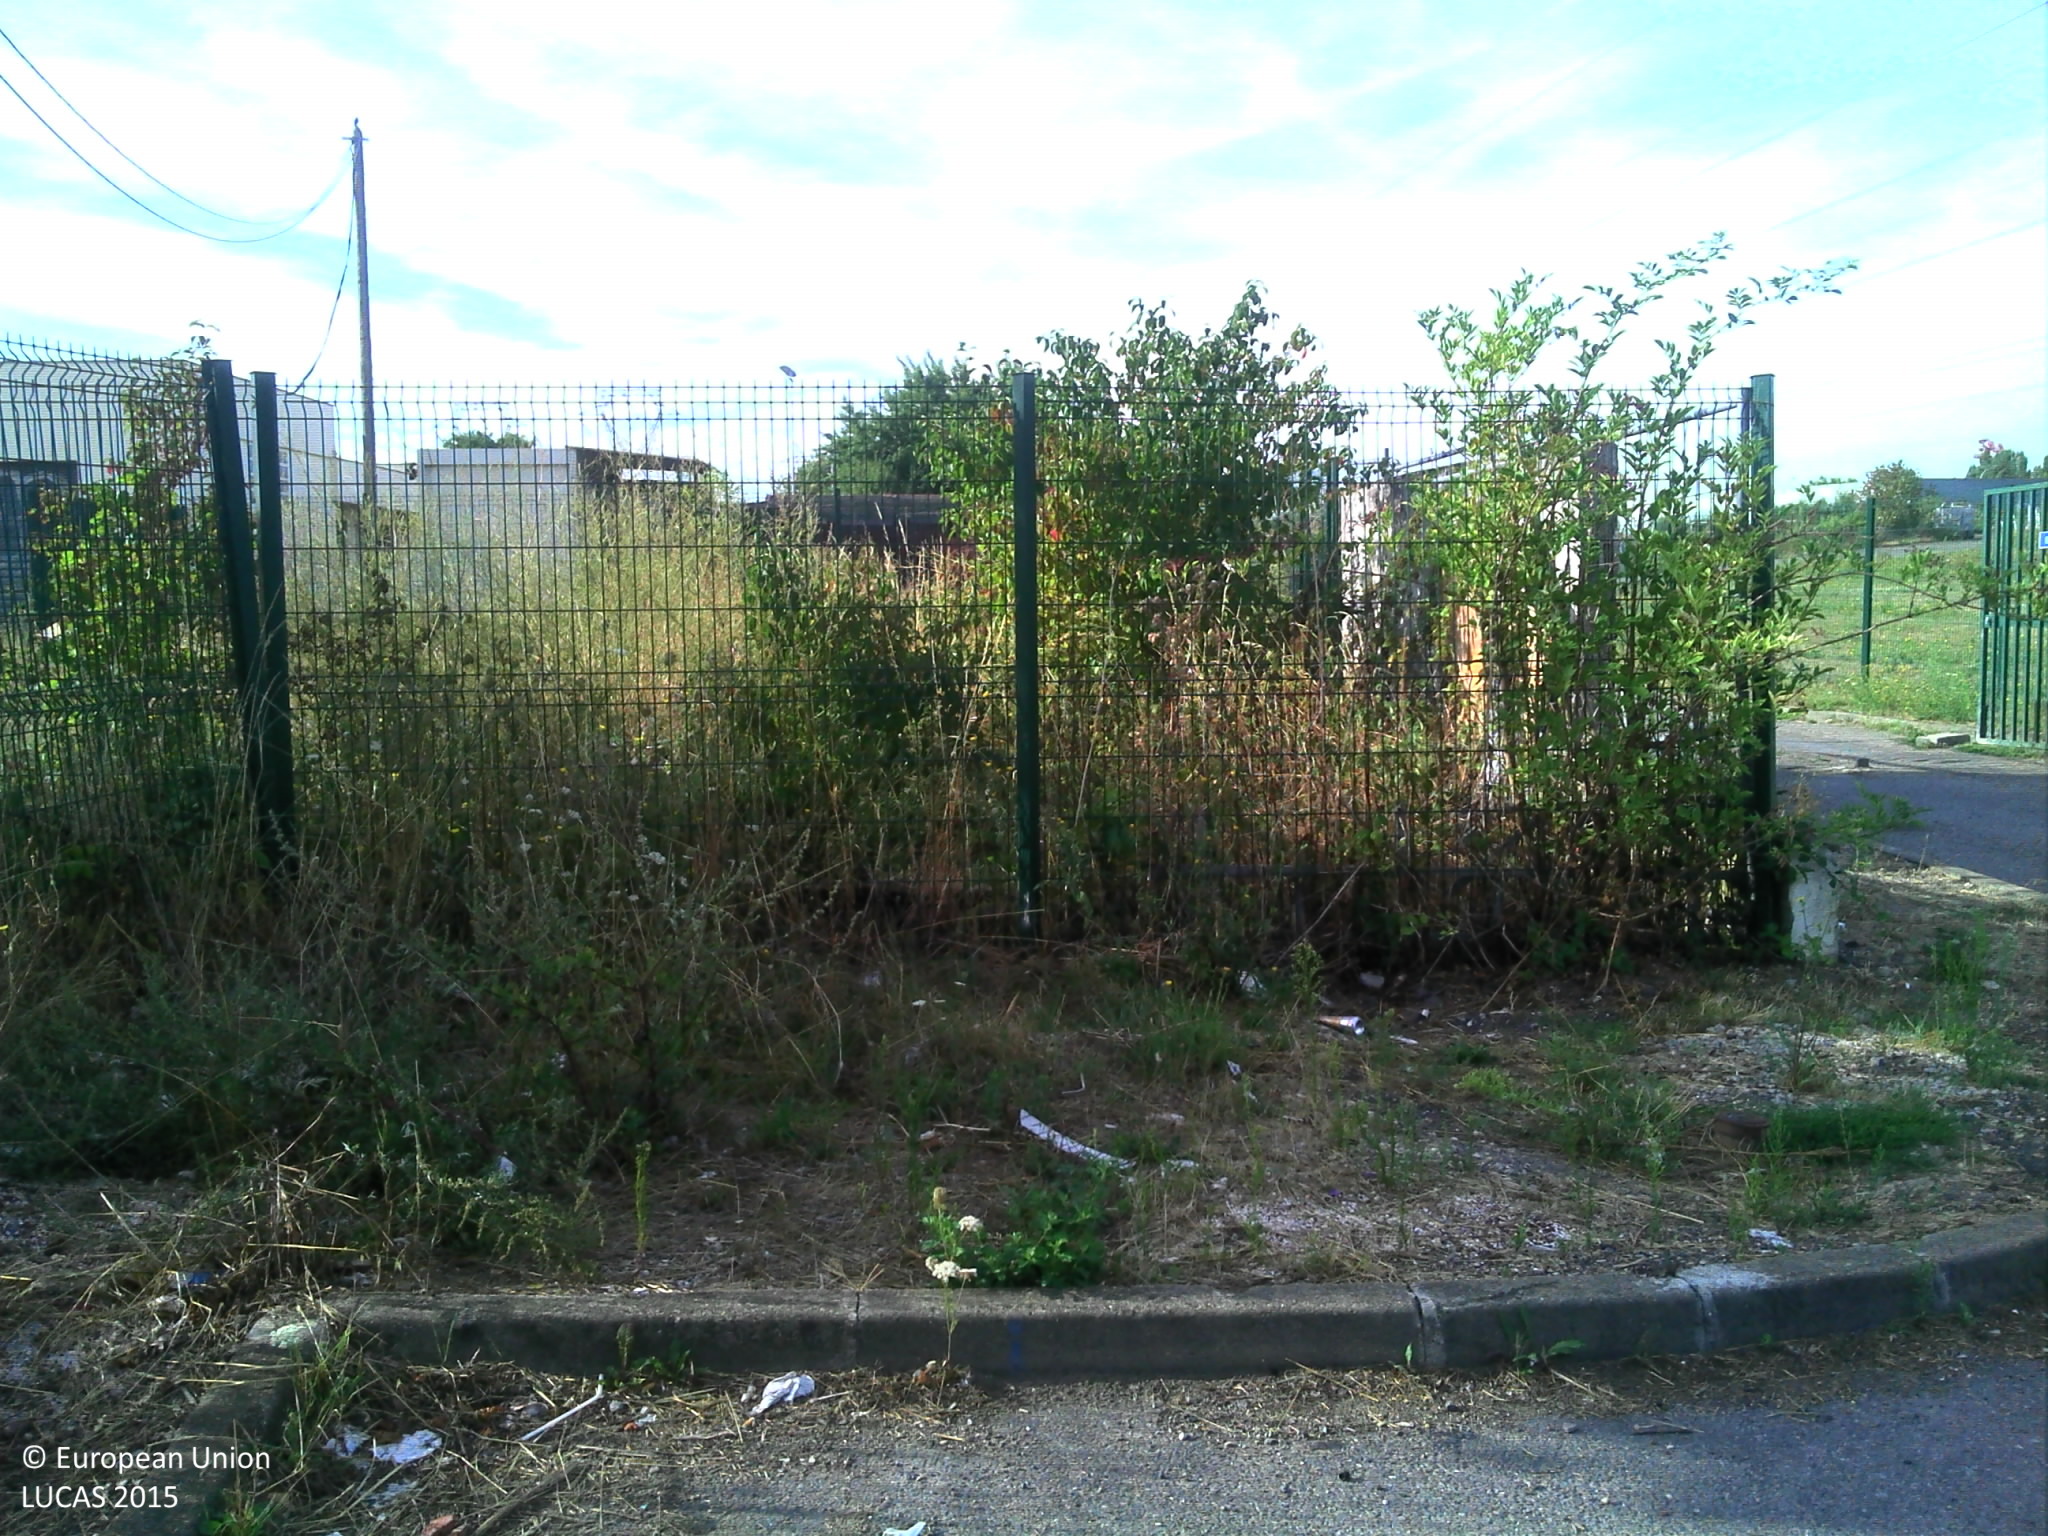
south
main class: Shrubland
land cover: Shrubland with sparse tree cover
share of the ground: > 75 %
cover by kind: shrubs 25 %, herbaceous plants 20 %, lichens and mosses 10 %, unconsolidated bare surface 10 %, broadleaved forest trees 5 %
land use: Abandoned areas
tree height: > 5 m
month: August
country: FR
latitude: 48.9522
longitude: 2.6289
